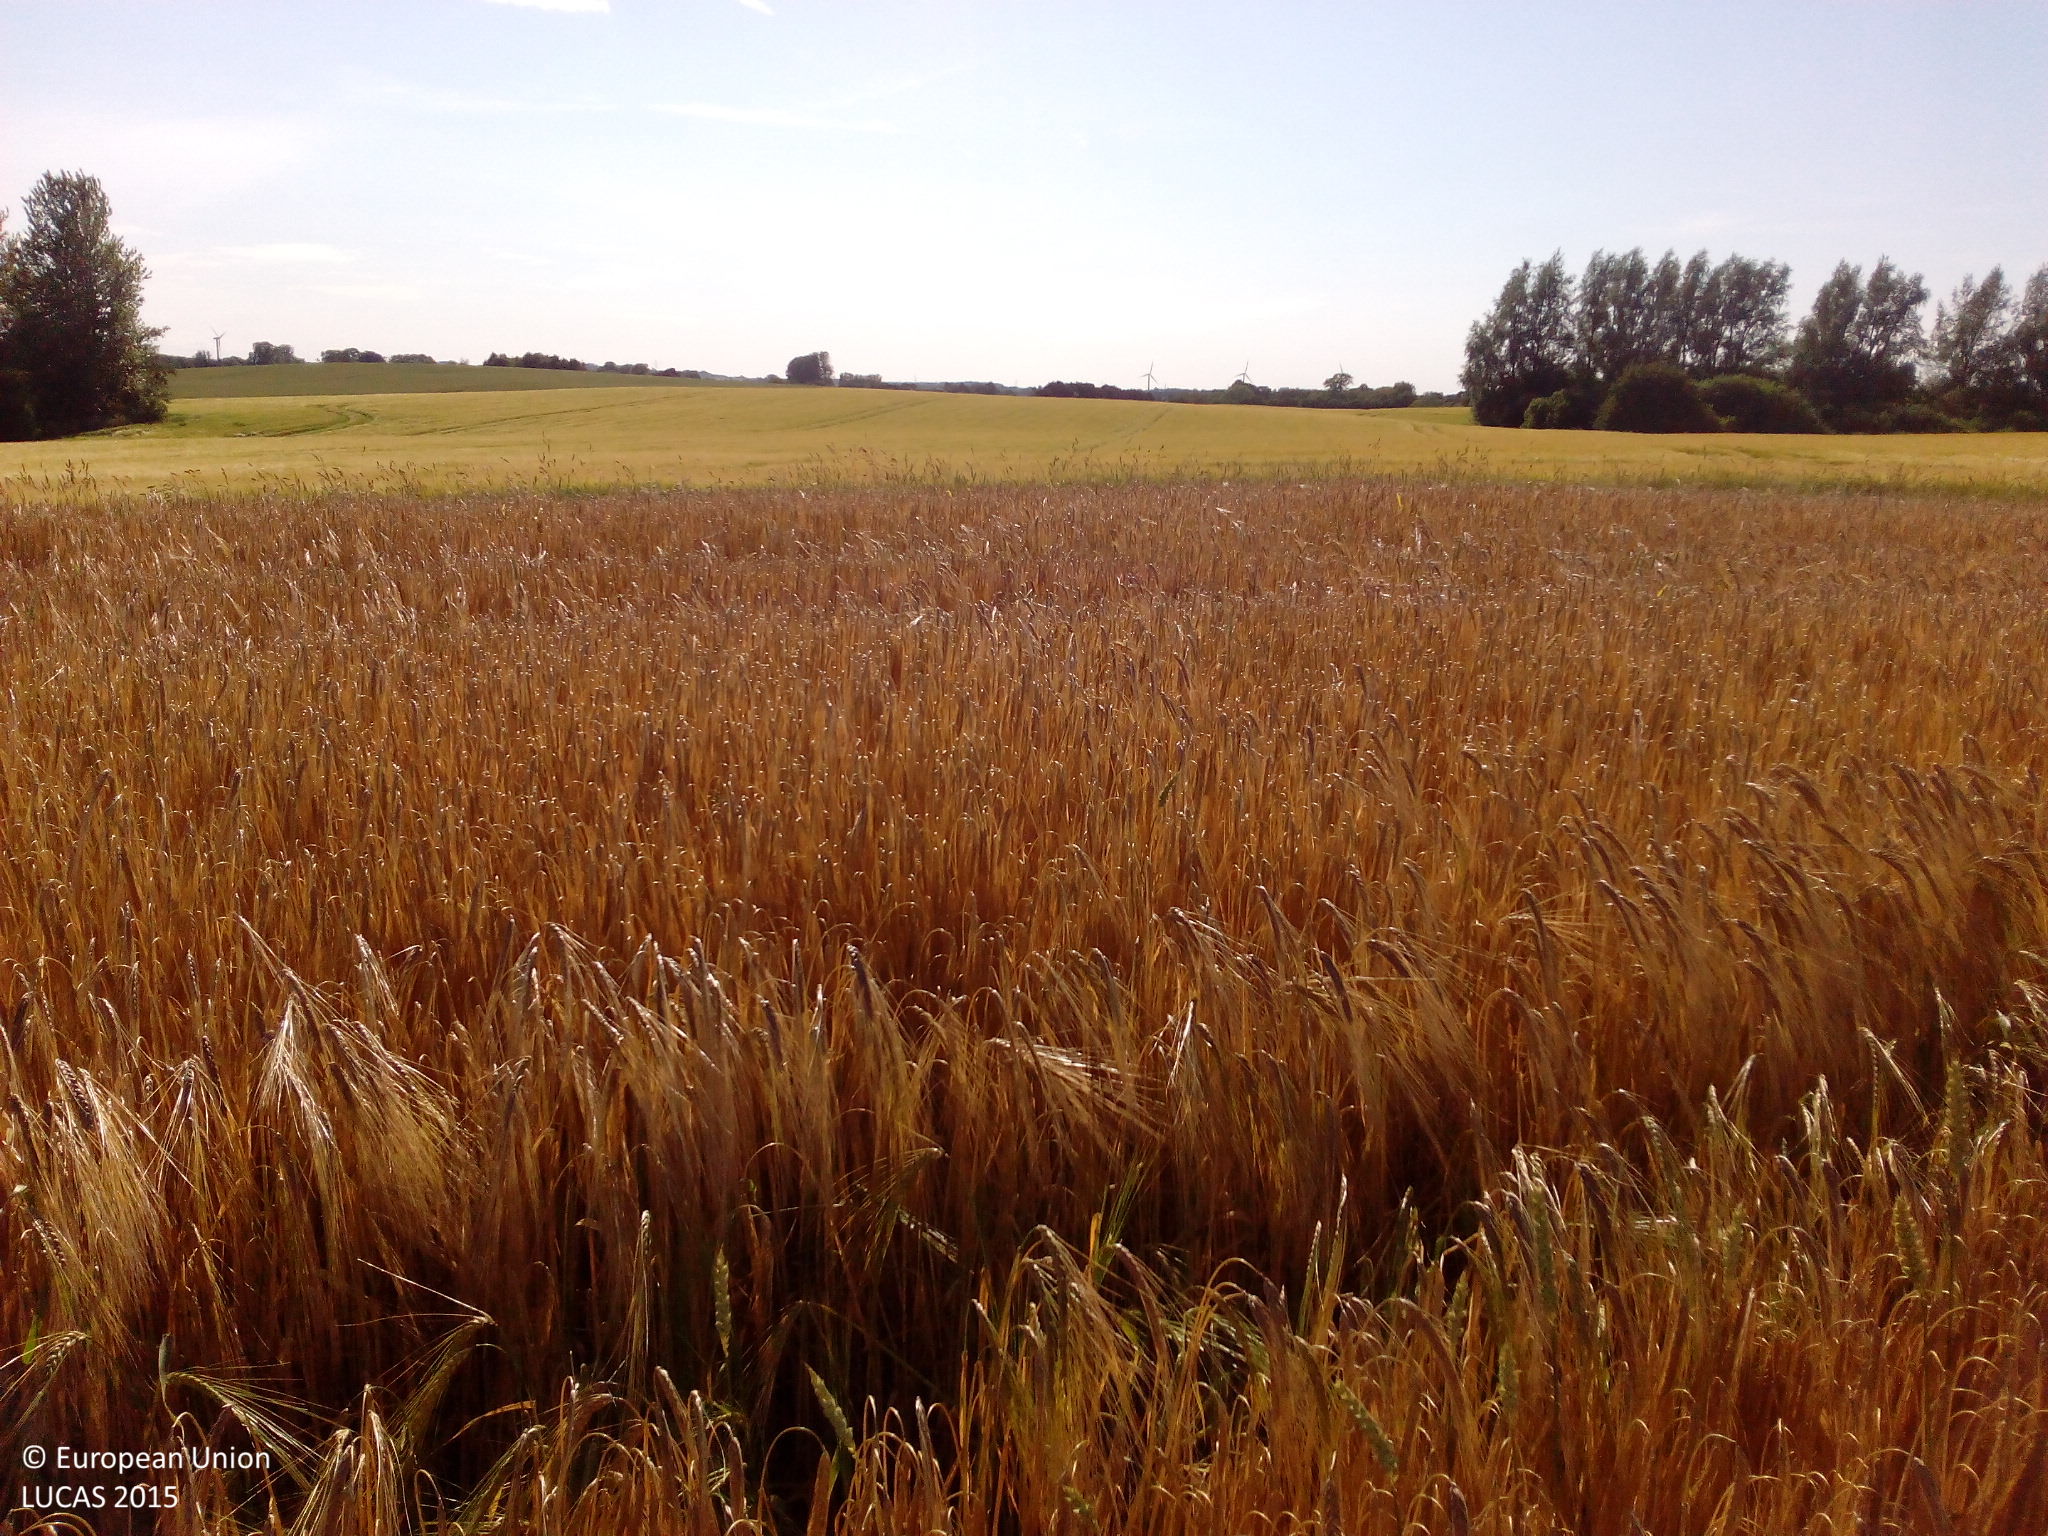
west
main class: Cropland
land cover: Barley
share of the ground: > 75 %
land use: Agriculture (excluding fallow land and kitchen gardens)
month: July
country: DK
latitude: 55.6555
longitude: 11.6673
